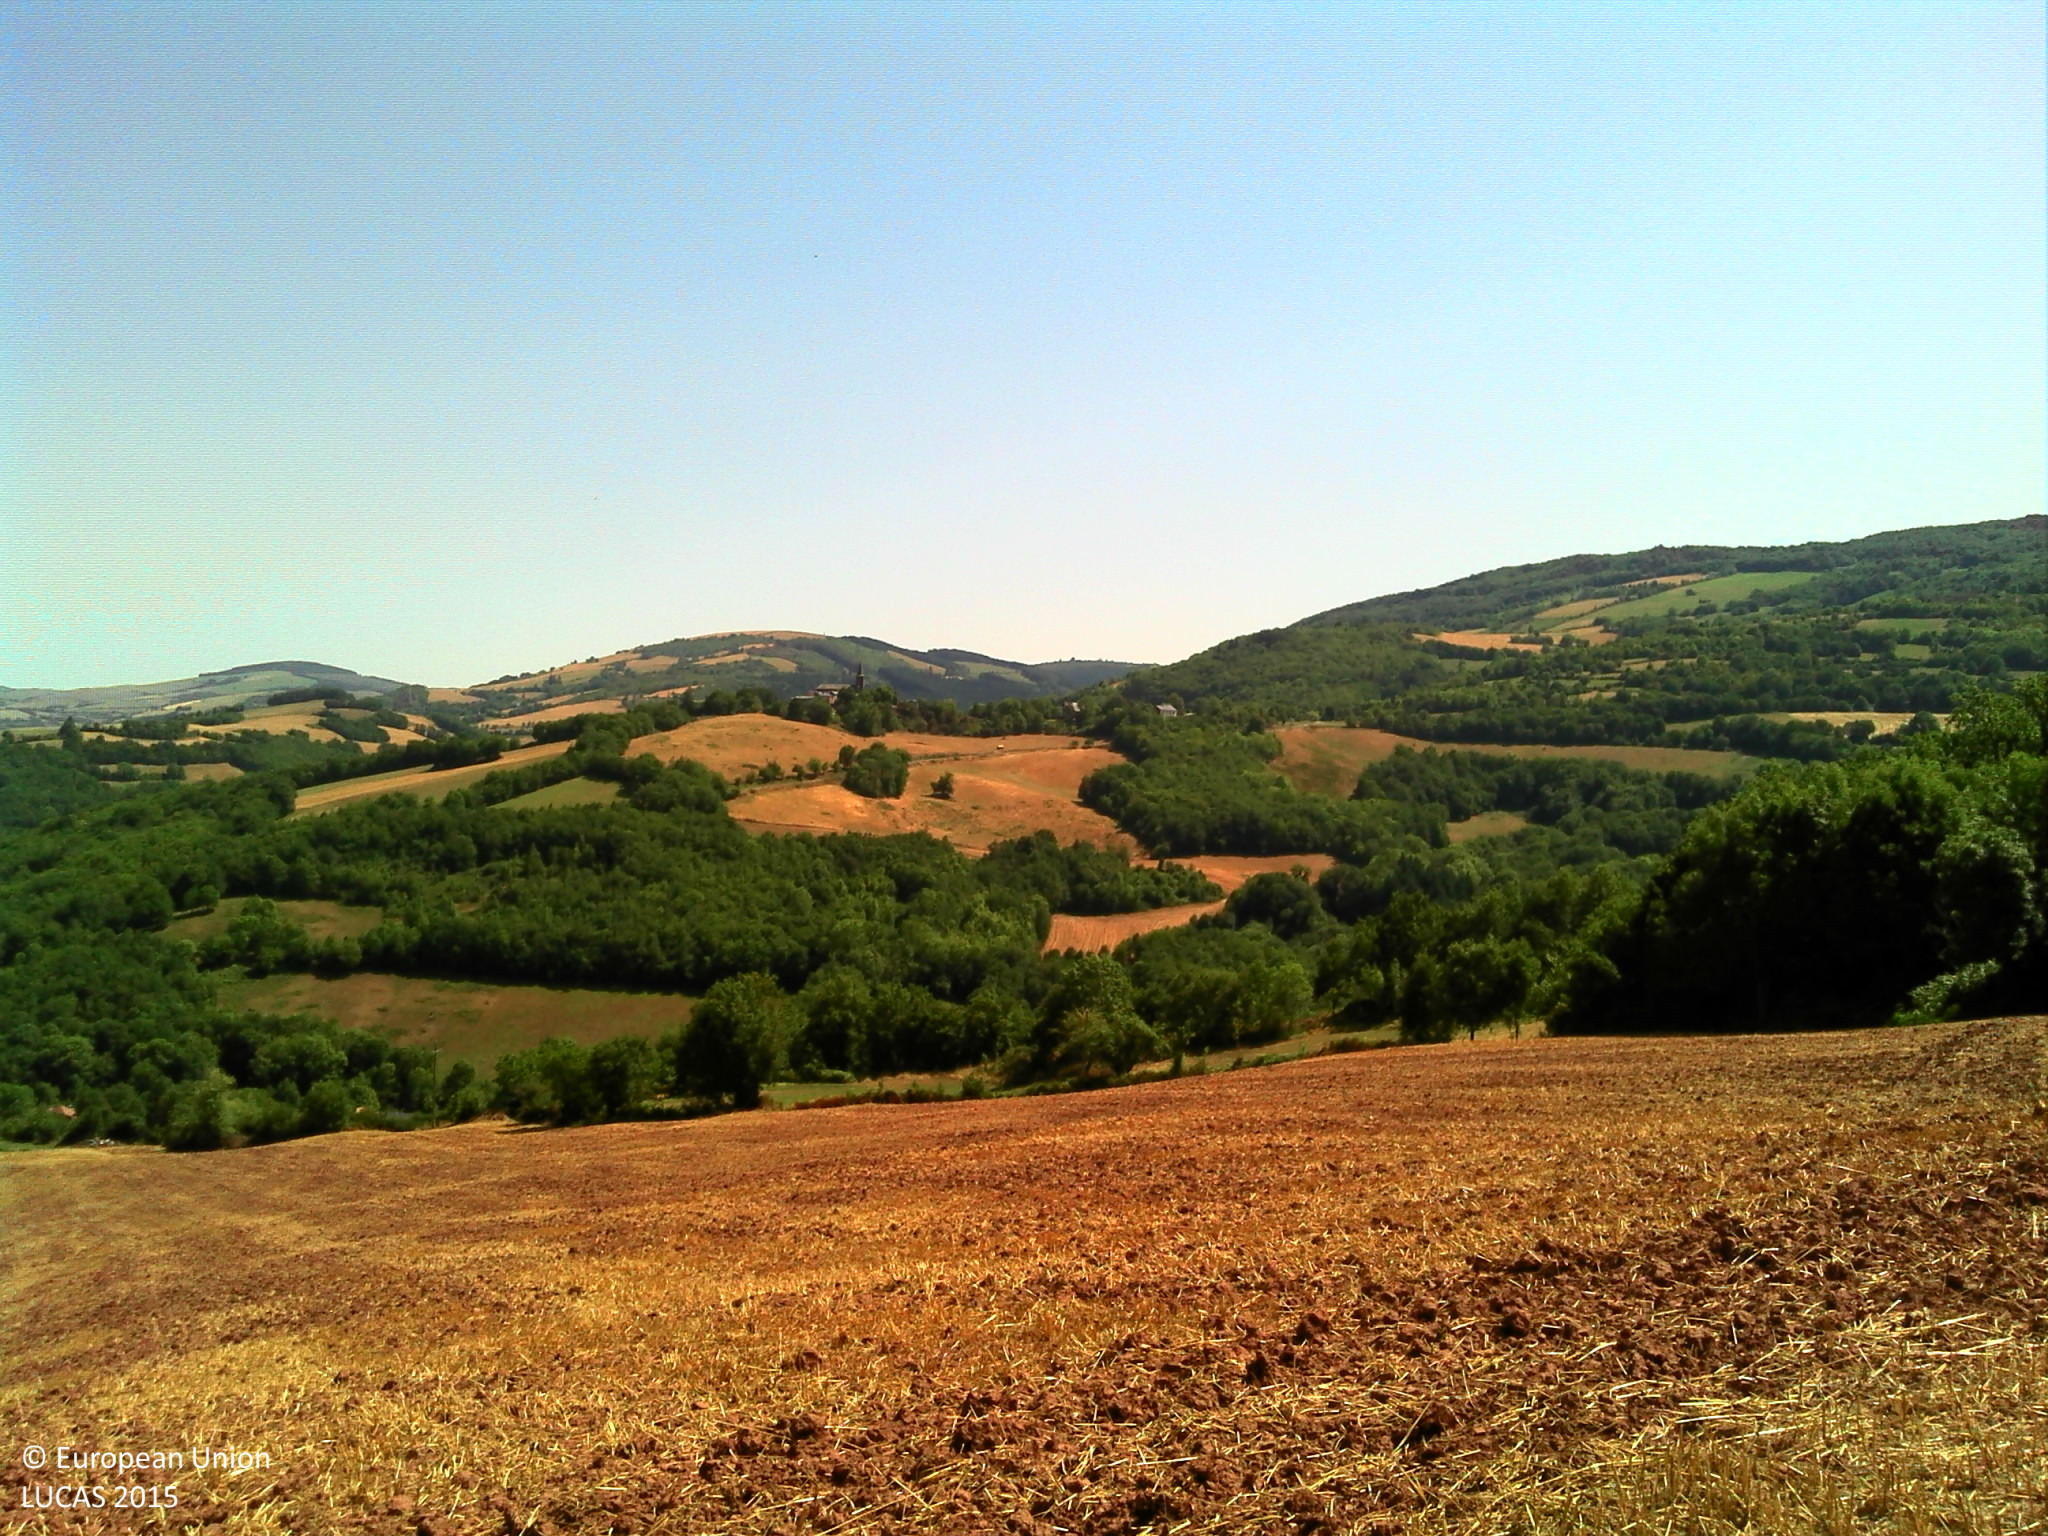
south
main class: Cropland
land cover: Barley
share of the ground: 25 - 50 %
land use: Agriculture (excluding fallow land and kitchen gardens)
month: August
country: FR
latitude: 43.8169
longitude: 2.6334
